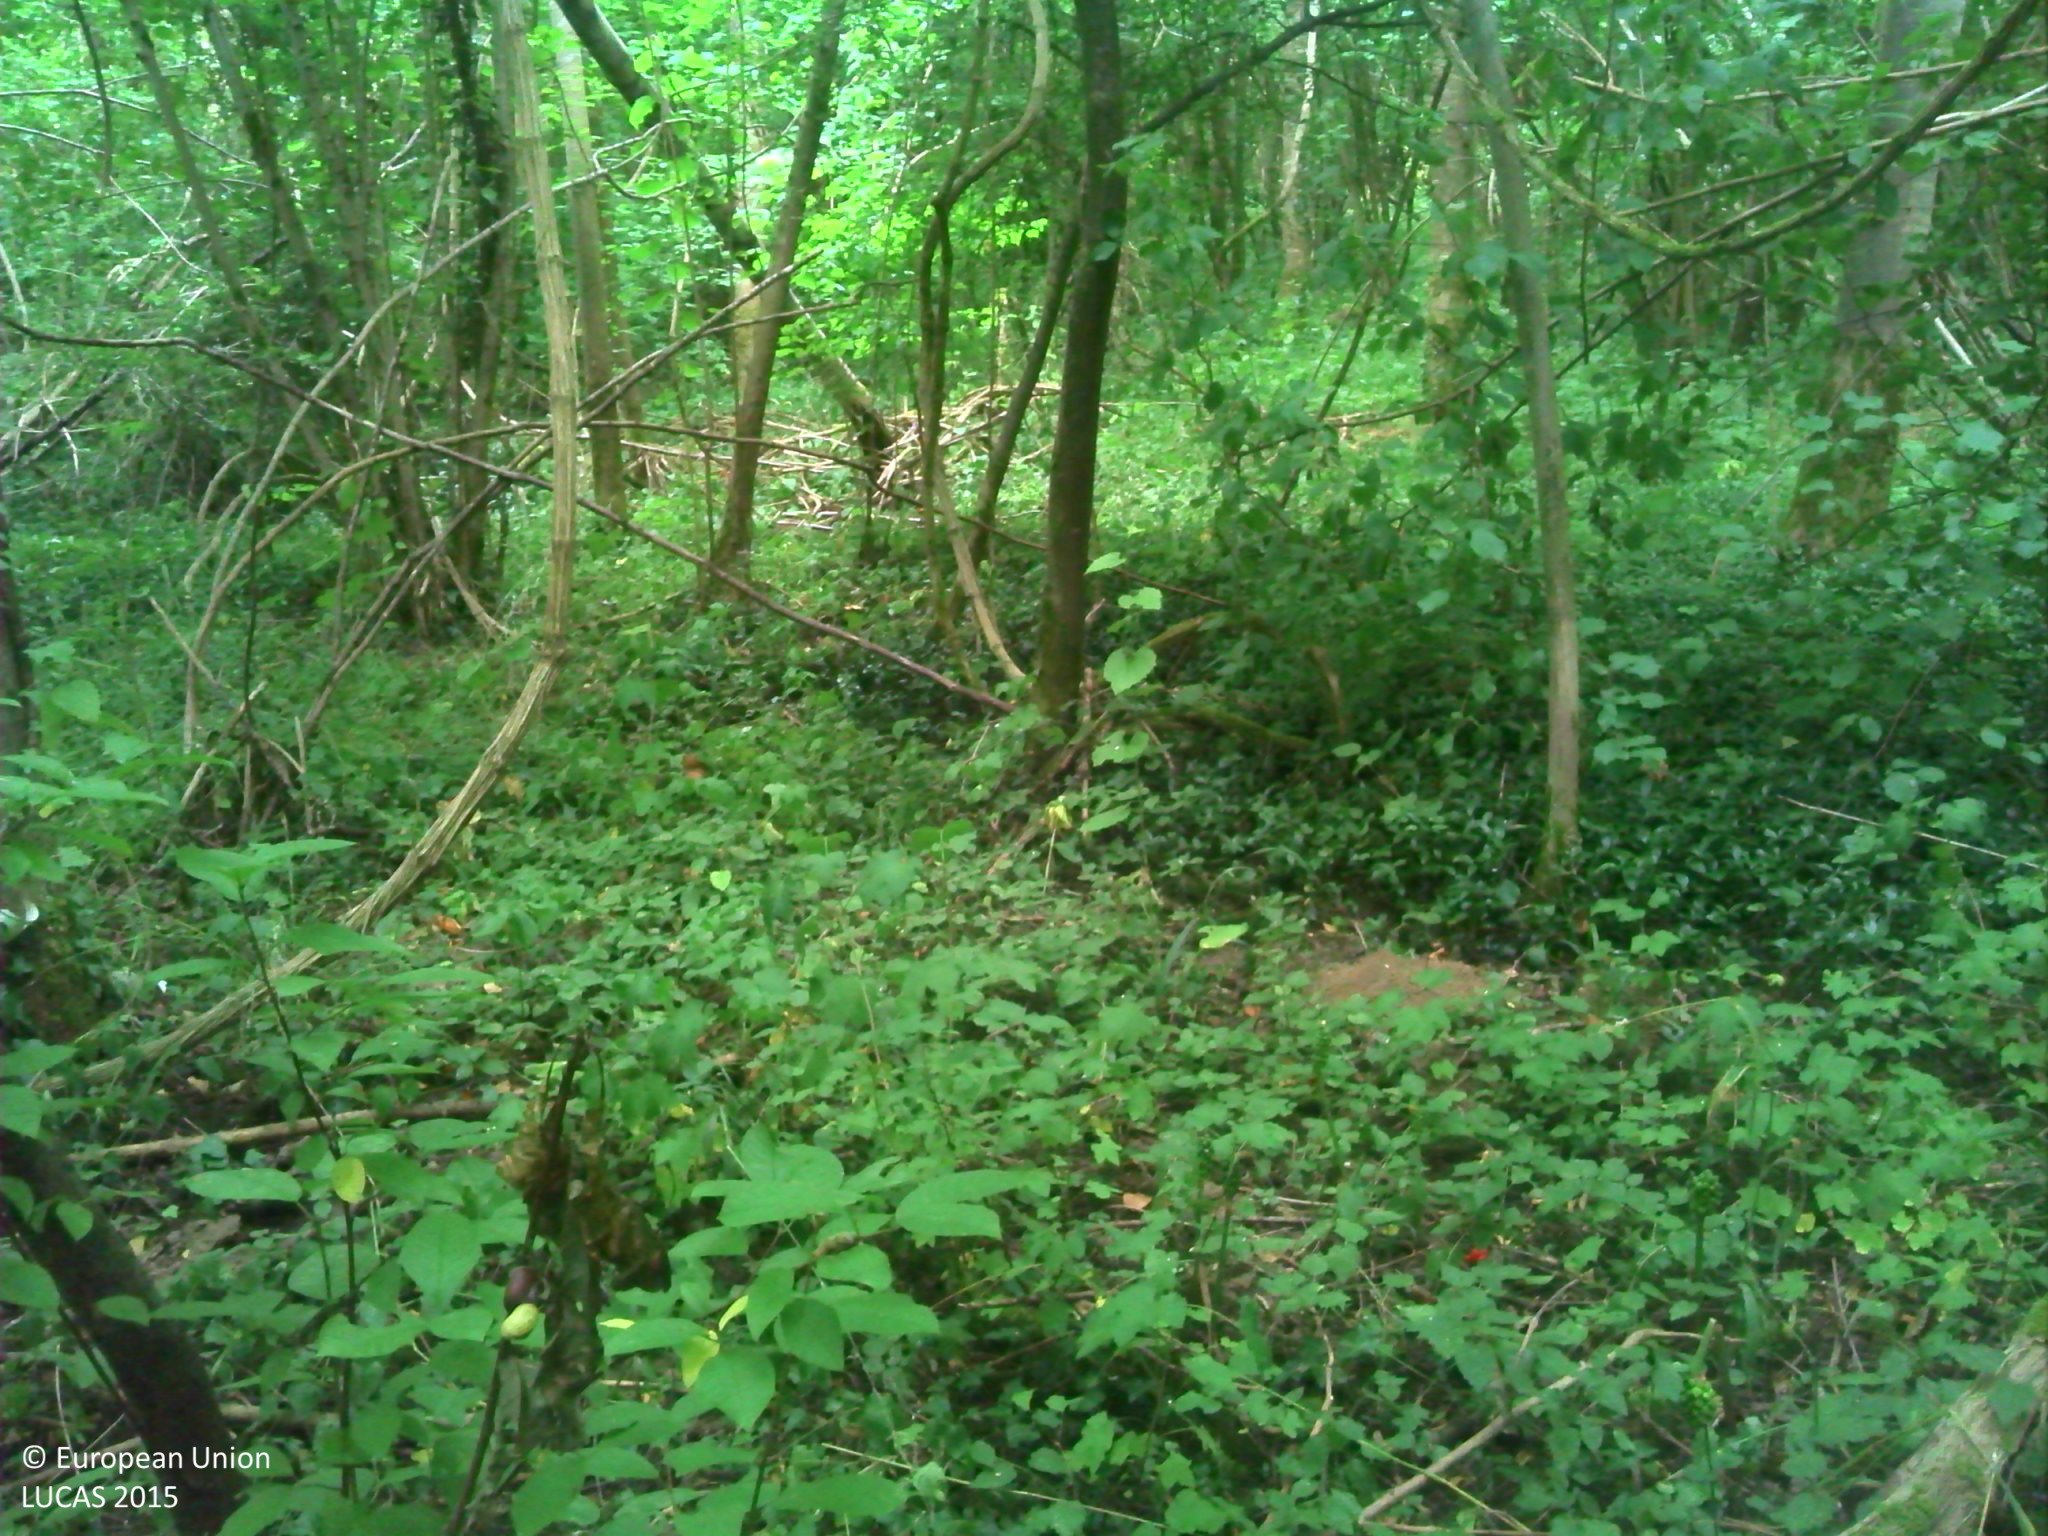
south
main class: Woodland
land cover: Broadleaved woodland
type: beech forest
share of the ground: > 75 %
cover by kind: broadleaved forest trees 90 %, herbaceous plants 10 %
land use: Forestry
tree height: > 5 m
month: July
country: FR
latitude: 49.3548
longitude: 3.2874
